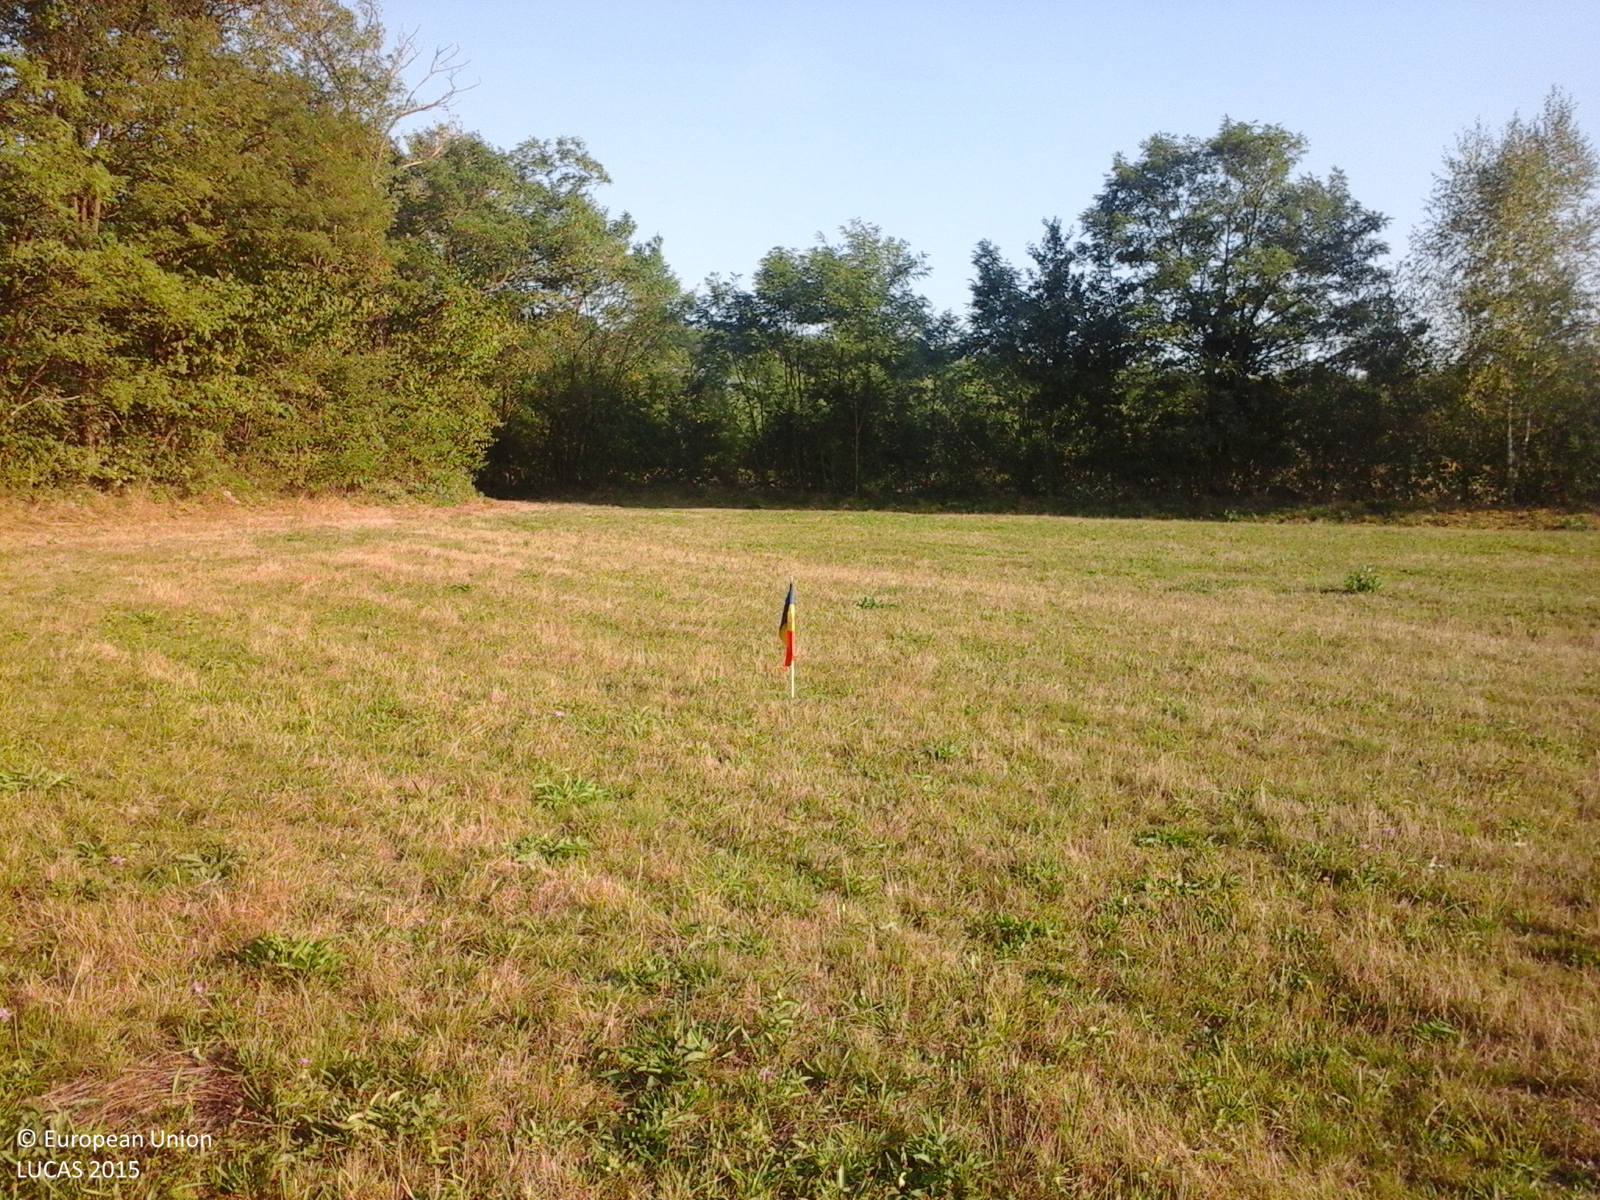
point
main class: Grassland
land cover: Grassland without tree/shrub cover
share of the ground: > 75 %
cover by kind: herbaceous plants 100 %
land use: Agriculture (excluding fallow land and kitchen gardens)
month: September
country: RO
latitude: 46.6968
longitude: 22.4360
